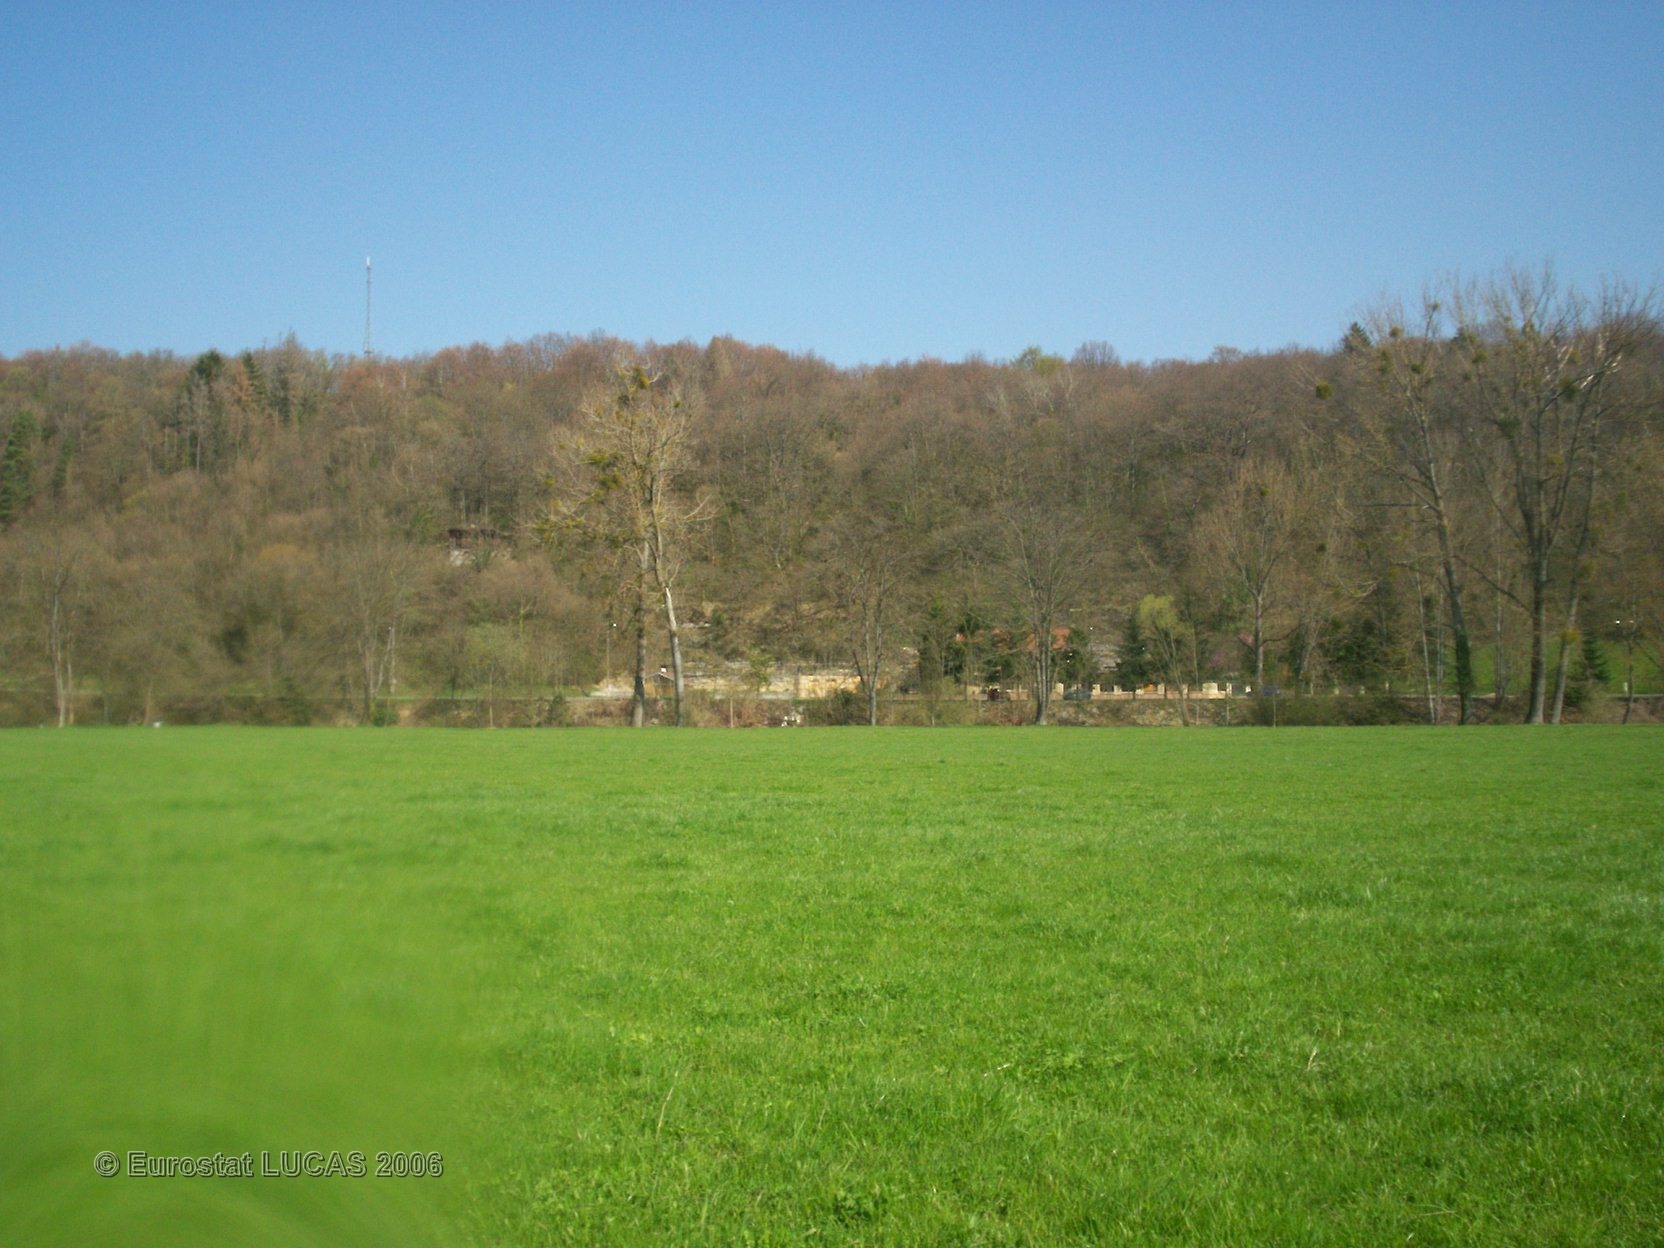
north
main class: Grassland
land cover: Grassland without tree/shrub cover
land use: Agriculture (excluding fallow land and kitchen gardens)
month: April
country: FR
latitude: 47.4568
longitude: 6.8050
